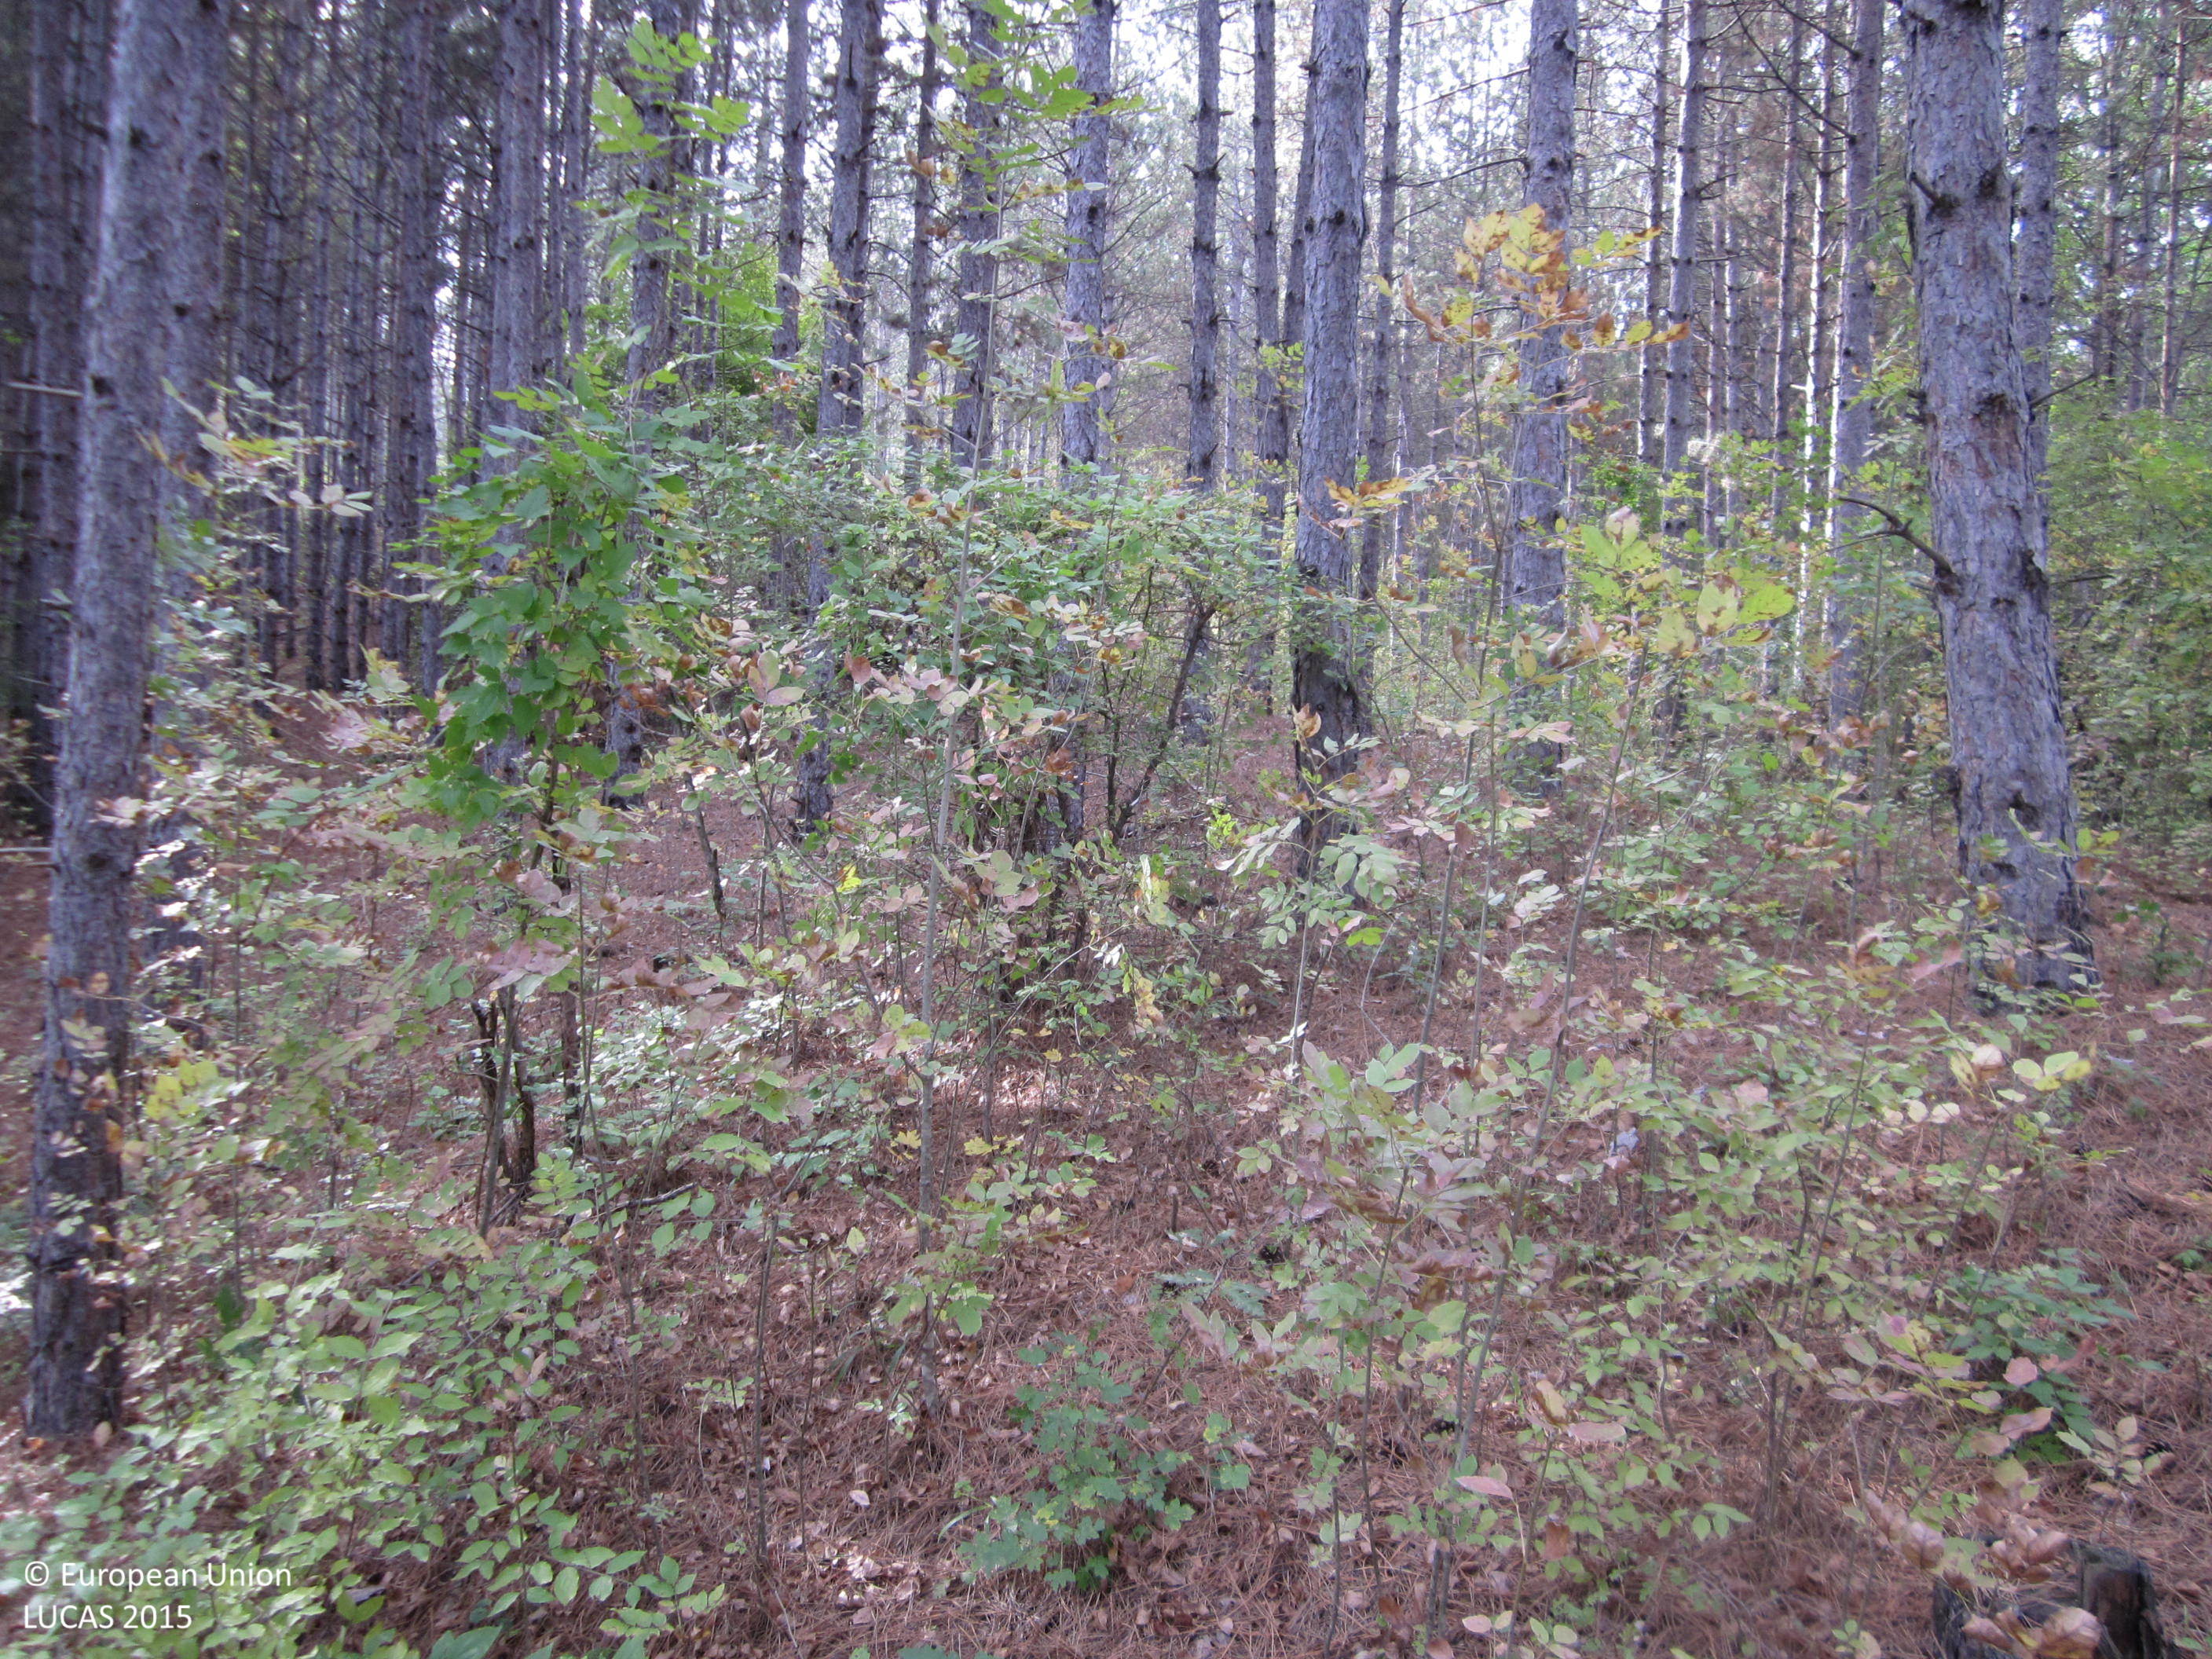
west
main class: Woodland
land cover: Pine dominated mixed woodland
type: hemiboreal forest and nemoral coniferous forest and mixed broadleaved-coniferous forest
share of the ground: > 75 %
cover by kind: coniferous forest trees 60 %, broadleaved forest trees 20 %, unconsolidated bare surface 15 %, herbaceous plants 5 %
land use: Forestry
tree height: > 5 m
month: October
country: BG
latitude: 42.8488
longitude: 26.8577
